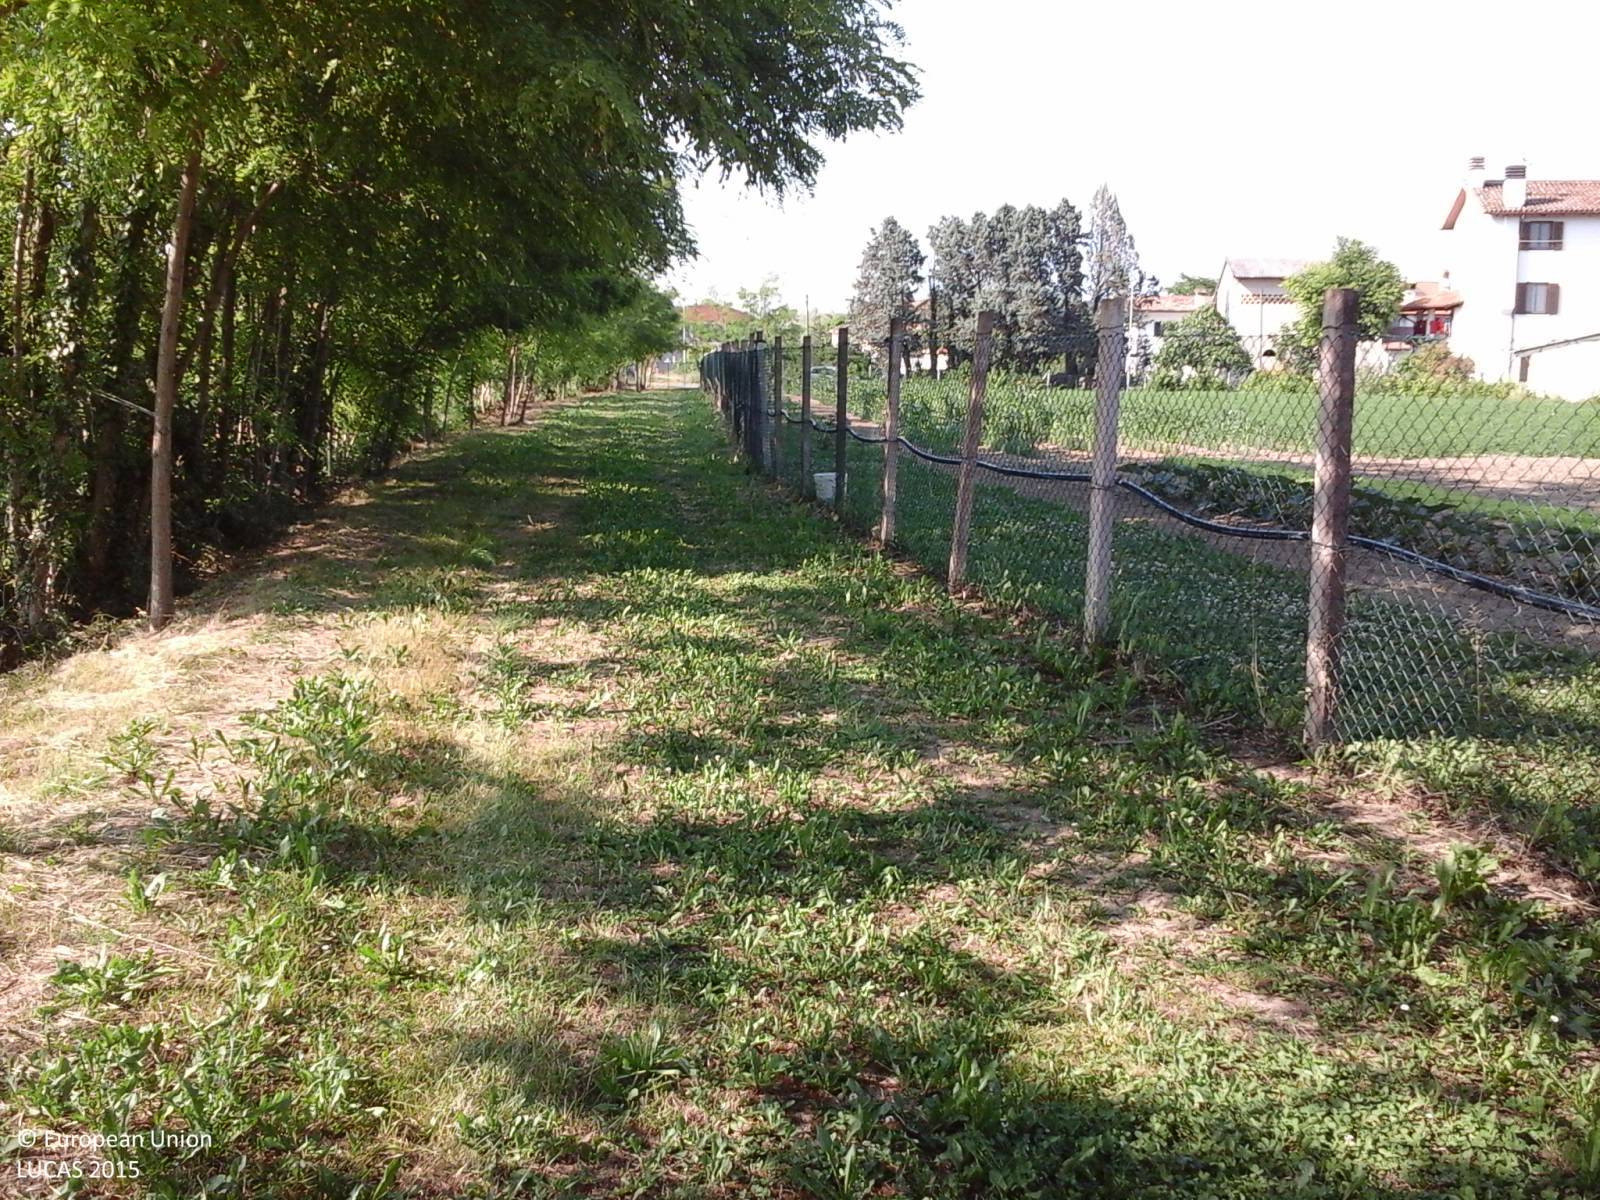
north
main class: Cropland
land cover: Other fresh vegetables
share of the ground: 50 - 75 %
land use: Kitchen garden
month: June
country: IT
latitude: 45.8290
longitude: 13.3816
